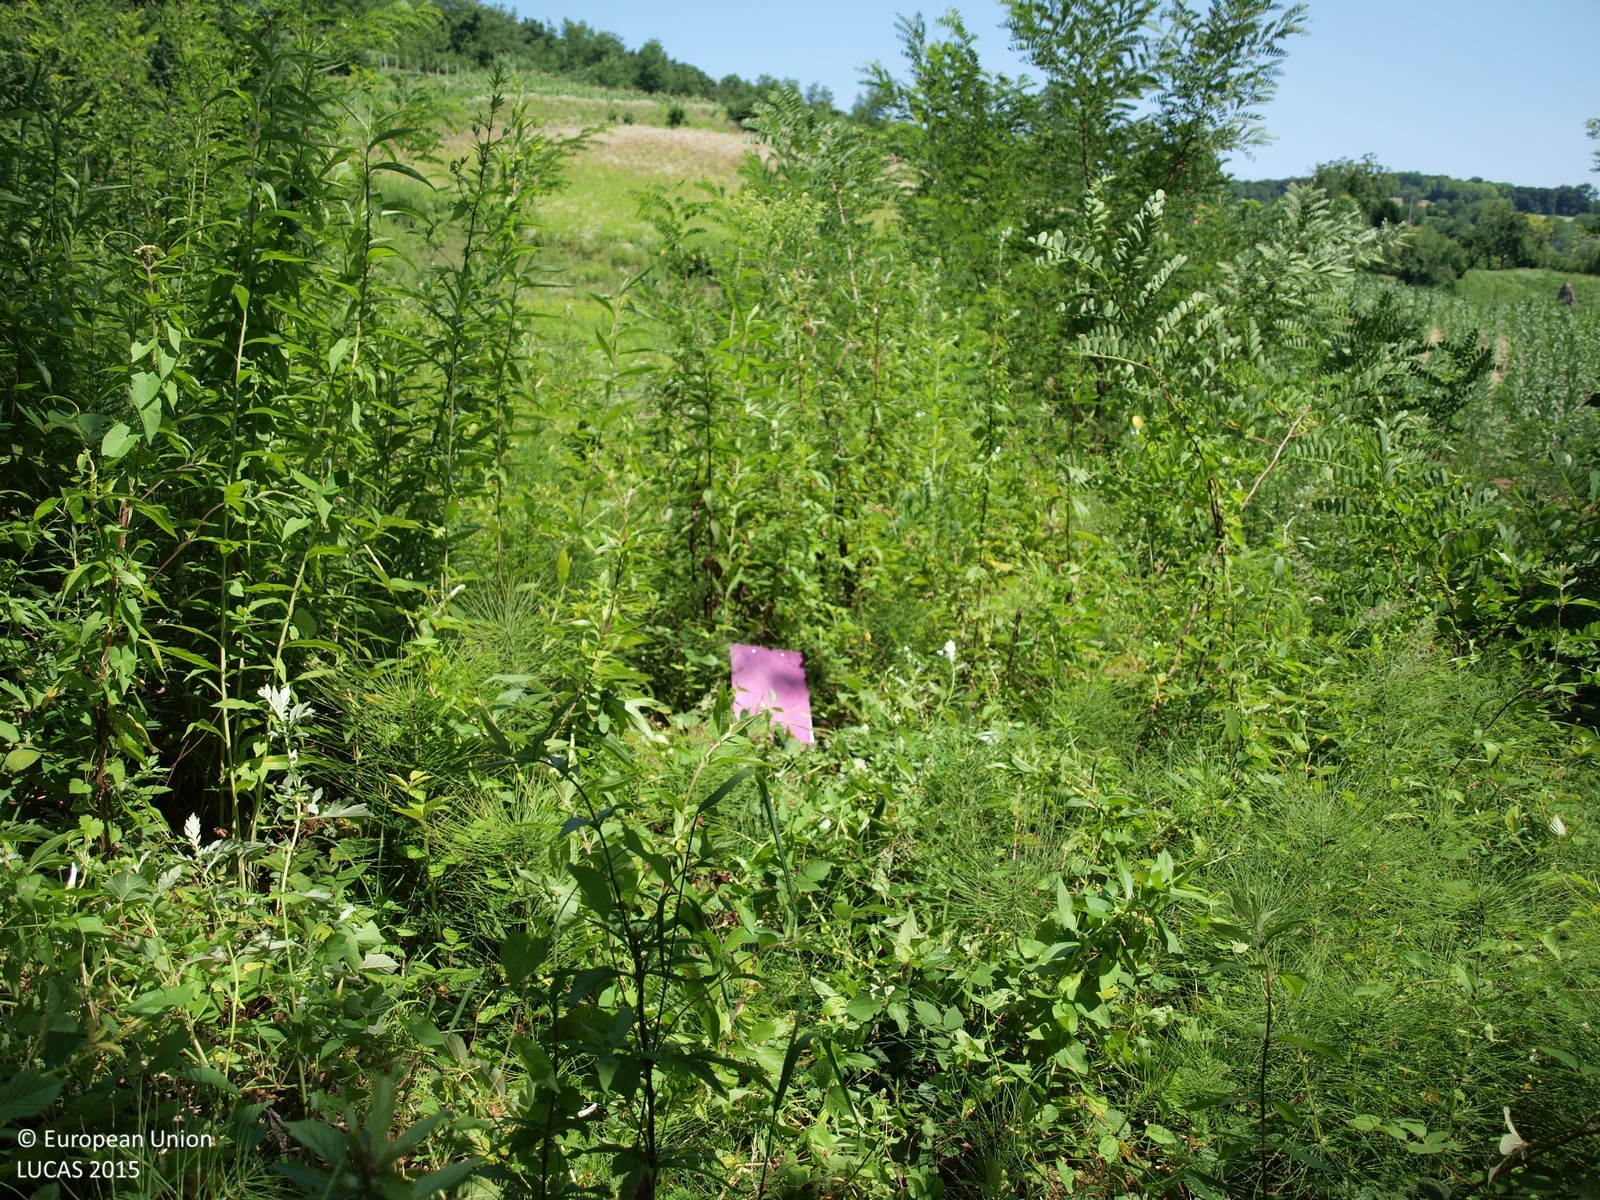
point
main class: Shrubland
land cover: Shrubland with sparse tree cover
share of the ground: > 75 %
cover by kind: shrubs 85 %, herbaceous plants 10 %, broadleaved forest trees 5 %
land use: Semi-natural and natural areas not in use
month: July
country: HR
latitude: 46.0781
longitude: 15.9337
